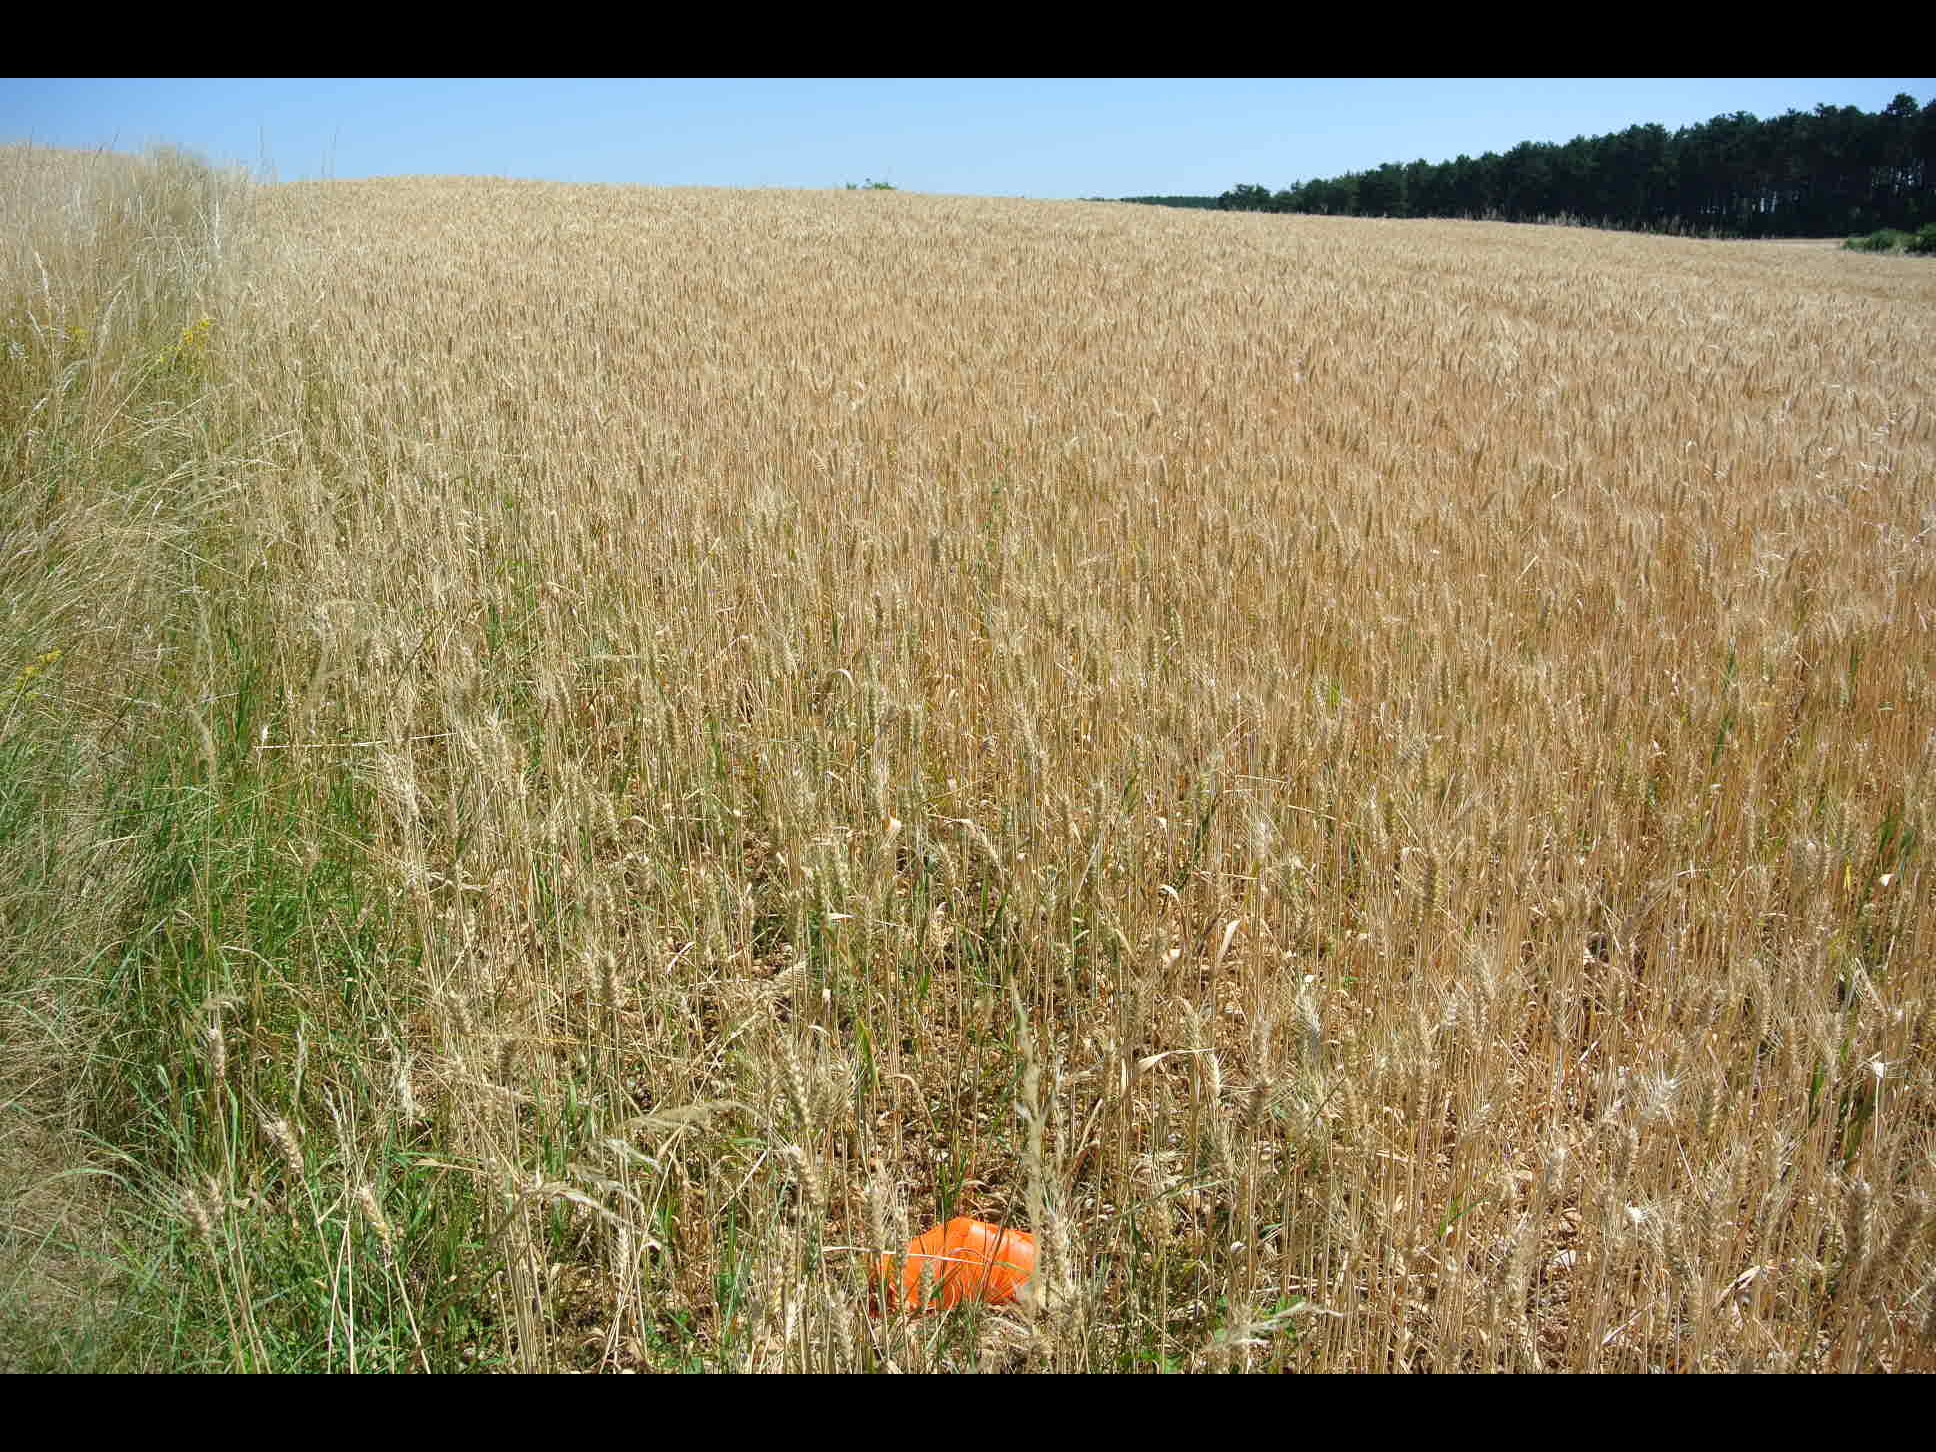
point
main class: Cropland
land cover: Durum wheat
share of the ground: > 75 %
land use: Agriculture (excluding fallow land and kitchen gardens)
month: July
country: AT
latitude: 47.7329
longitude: 16.0432
